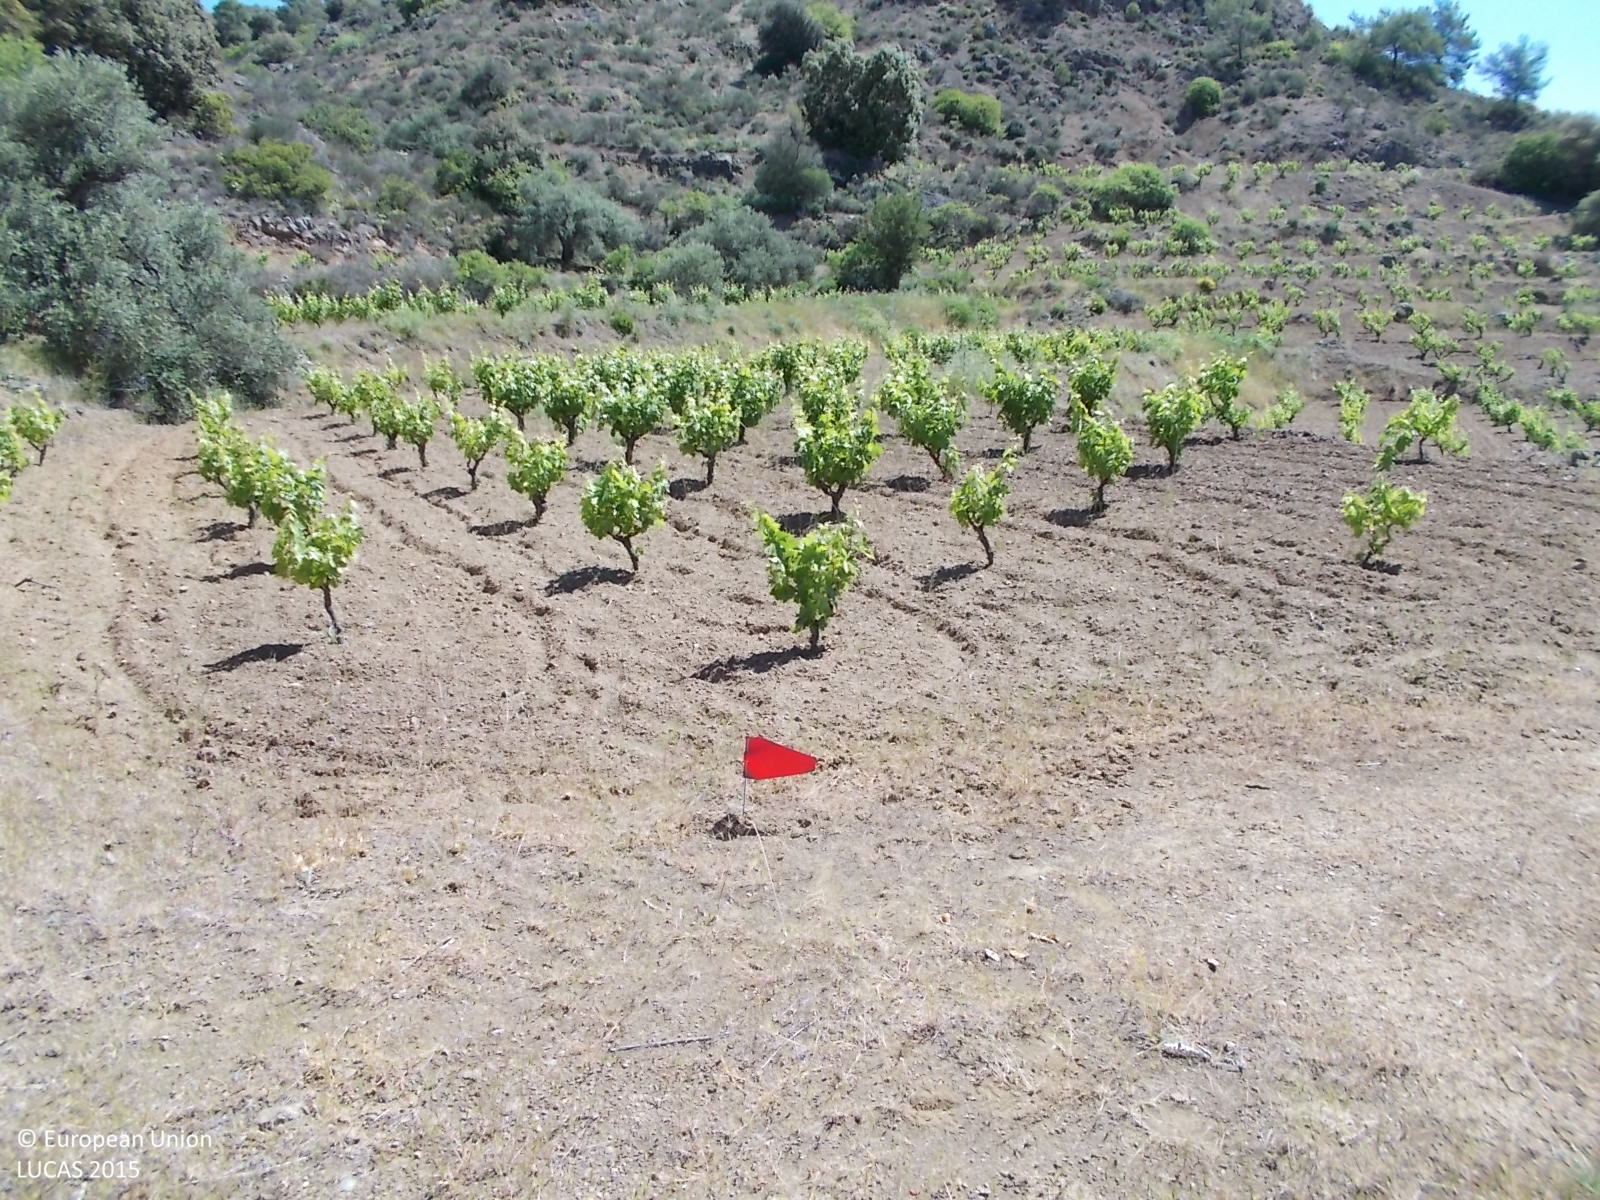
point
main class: Cropland
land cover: Vineyards
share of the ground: > 75 %
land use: Agriculture (excluding fallow land and kitchen gardens)
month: May
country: CY
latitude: 34.8463
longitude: 33.0153
